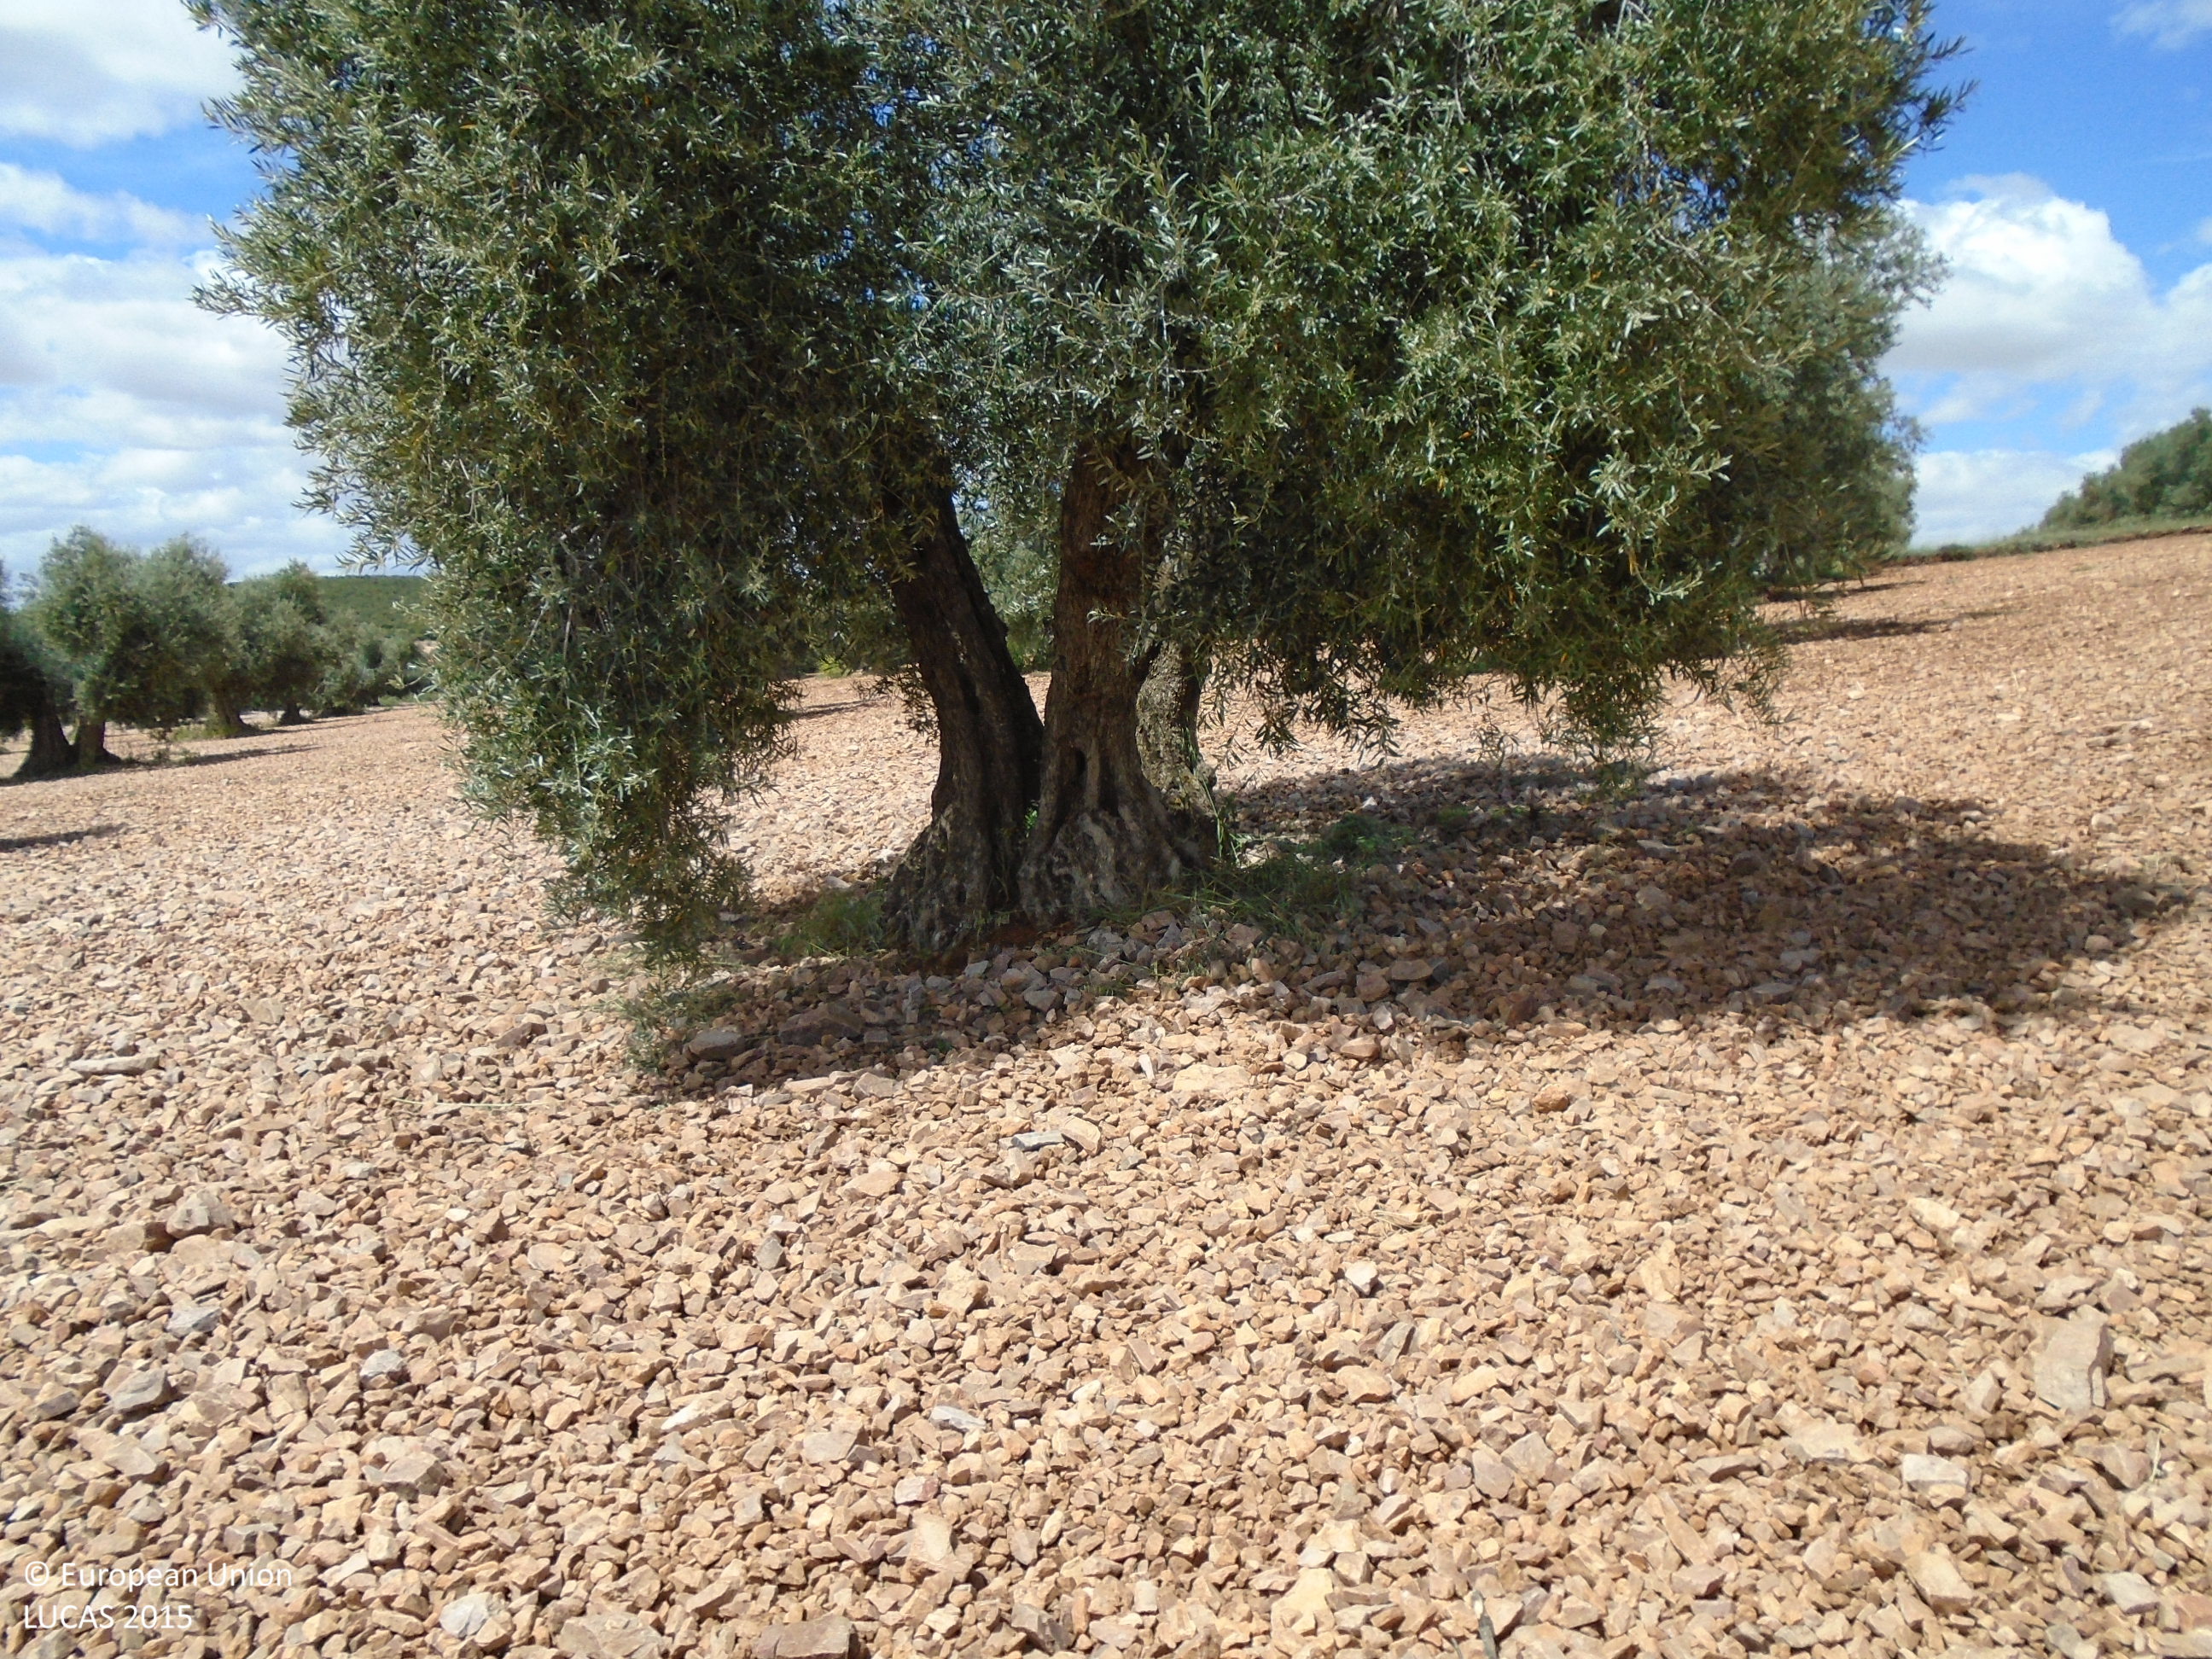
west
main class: Cropland
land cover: Olive groves
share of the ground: 10 - 25 %
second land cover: Other bare soil
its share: > 75 %
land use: Agriculture (excluding fallow land and kitchen gardens)
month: May
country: ES
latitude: 39.6288
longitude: -3.7164
